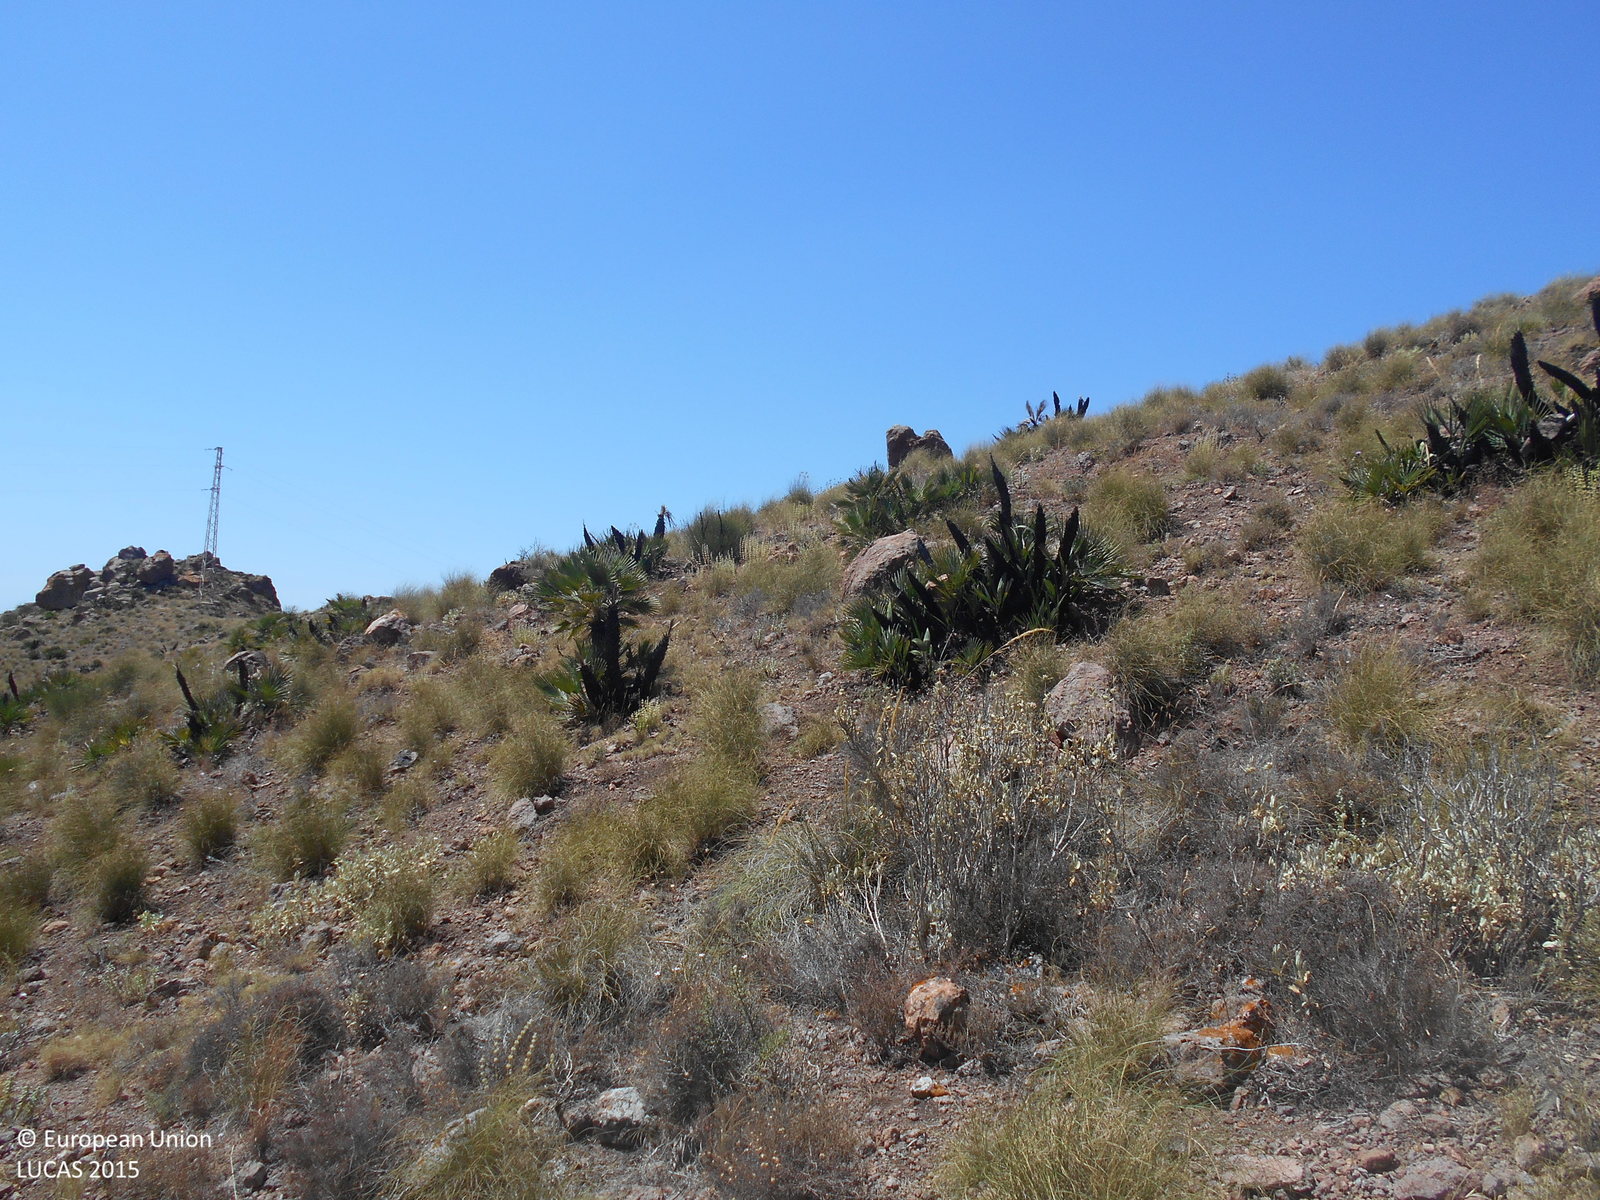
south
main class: Shrubland
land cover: Shrubland without tree cover
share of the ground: 25 - 50 %
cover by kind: shrubs 30 %, consolidated bare surface 30 %, unconsolidated bare surface 30 %, herbaceous plants 10 %
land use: Semi-natural and natural areas not in use
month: May
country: ES
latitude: 36.8054
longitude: -2.1115
